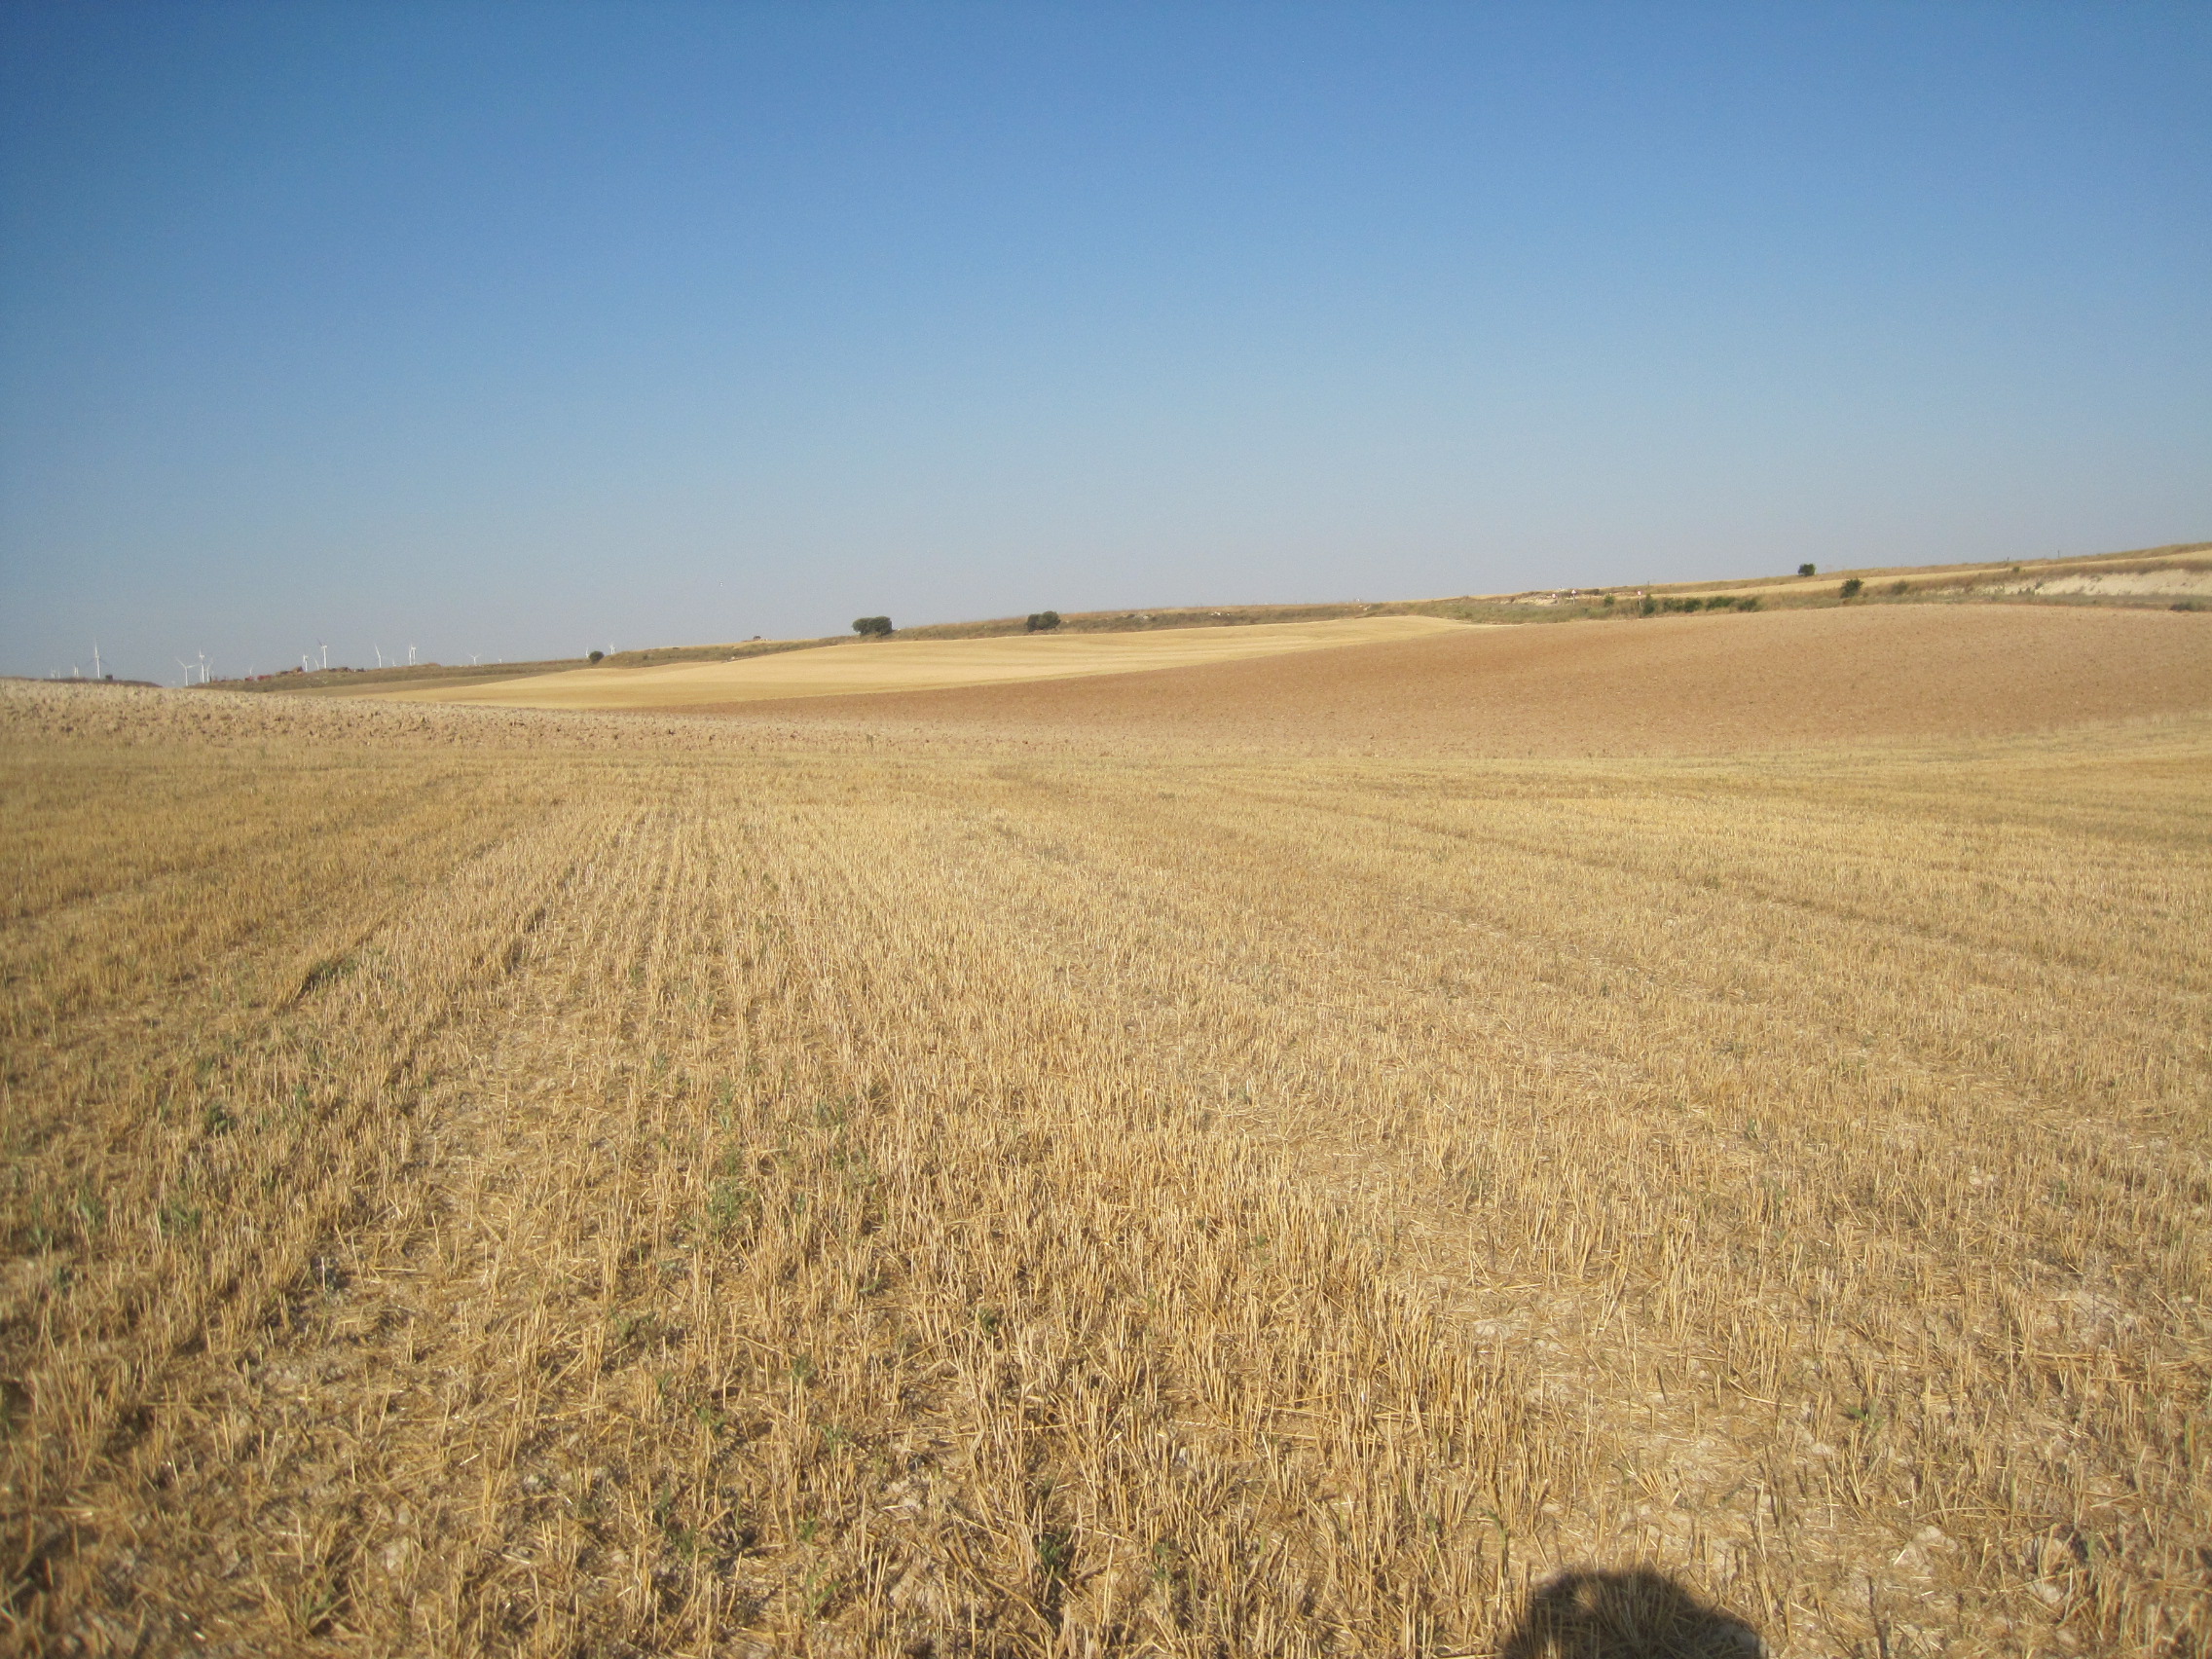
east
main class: Cropland
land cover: Barley
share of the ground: < 10 %
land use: Agriculture (excluding fallow land and kitchen gardens)
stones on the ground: 10 - 25 %
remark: Harvested field
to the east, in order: Barley; Grass margins; Other bare soil
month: July
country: ES
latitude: 41.6753
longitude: -5.1276
